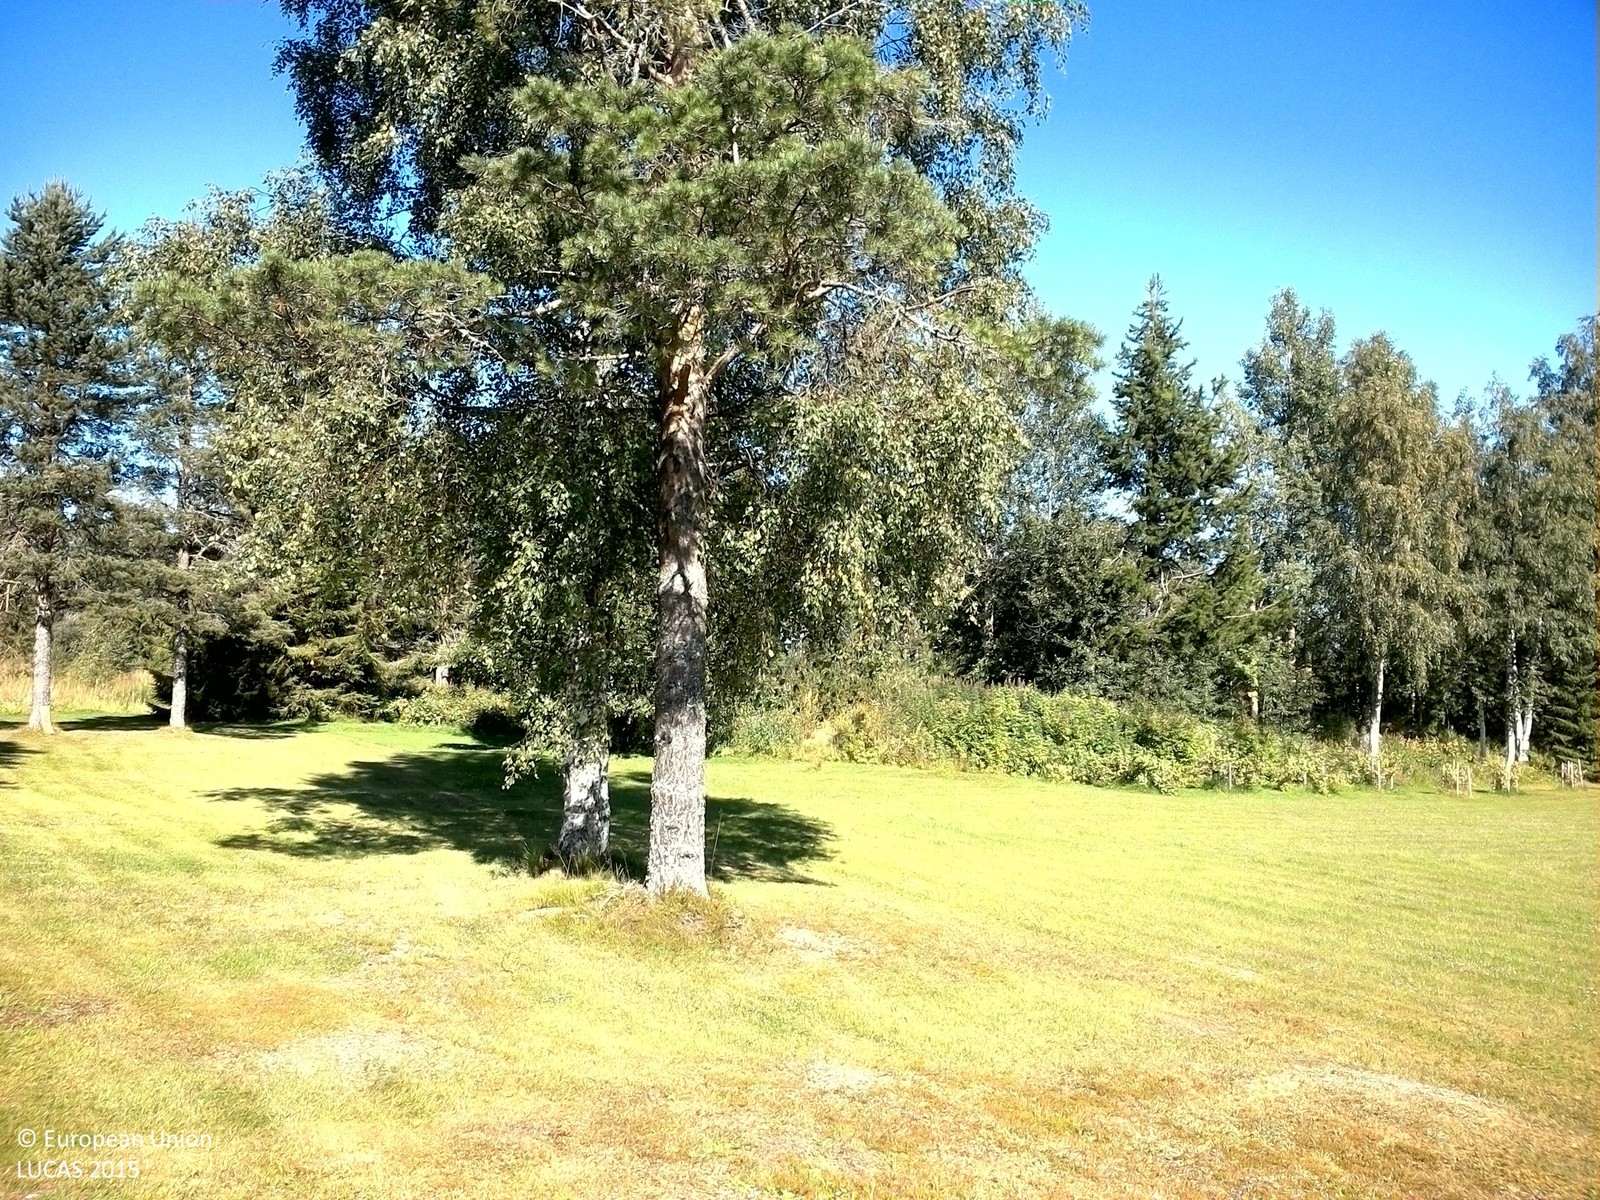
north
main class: Grassland
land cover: Grassland without tree/shrub cover
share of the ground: > 75 %
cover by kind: herbaceous plants 80 %, lichens and mosses 20 %
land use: Residential
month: August
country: SE
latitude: 63.7118
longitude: 17.8860
